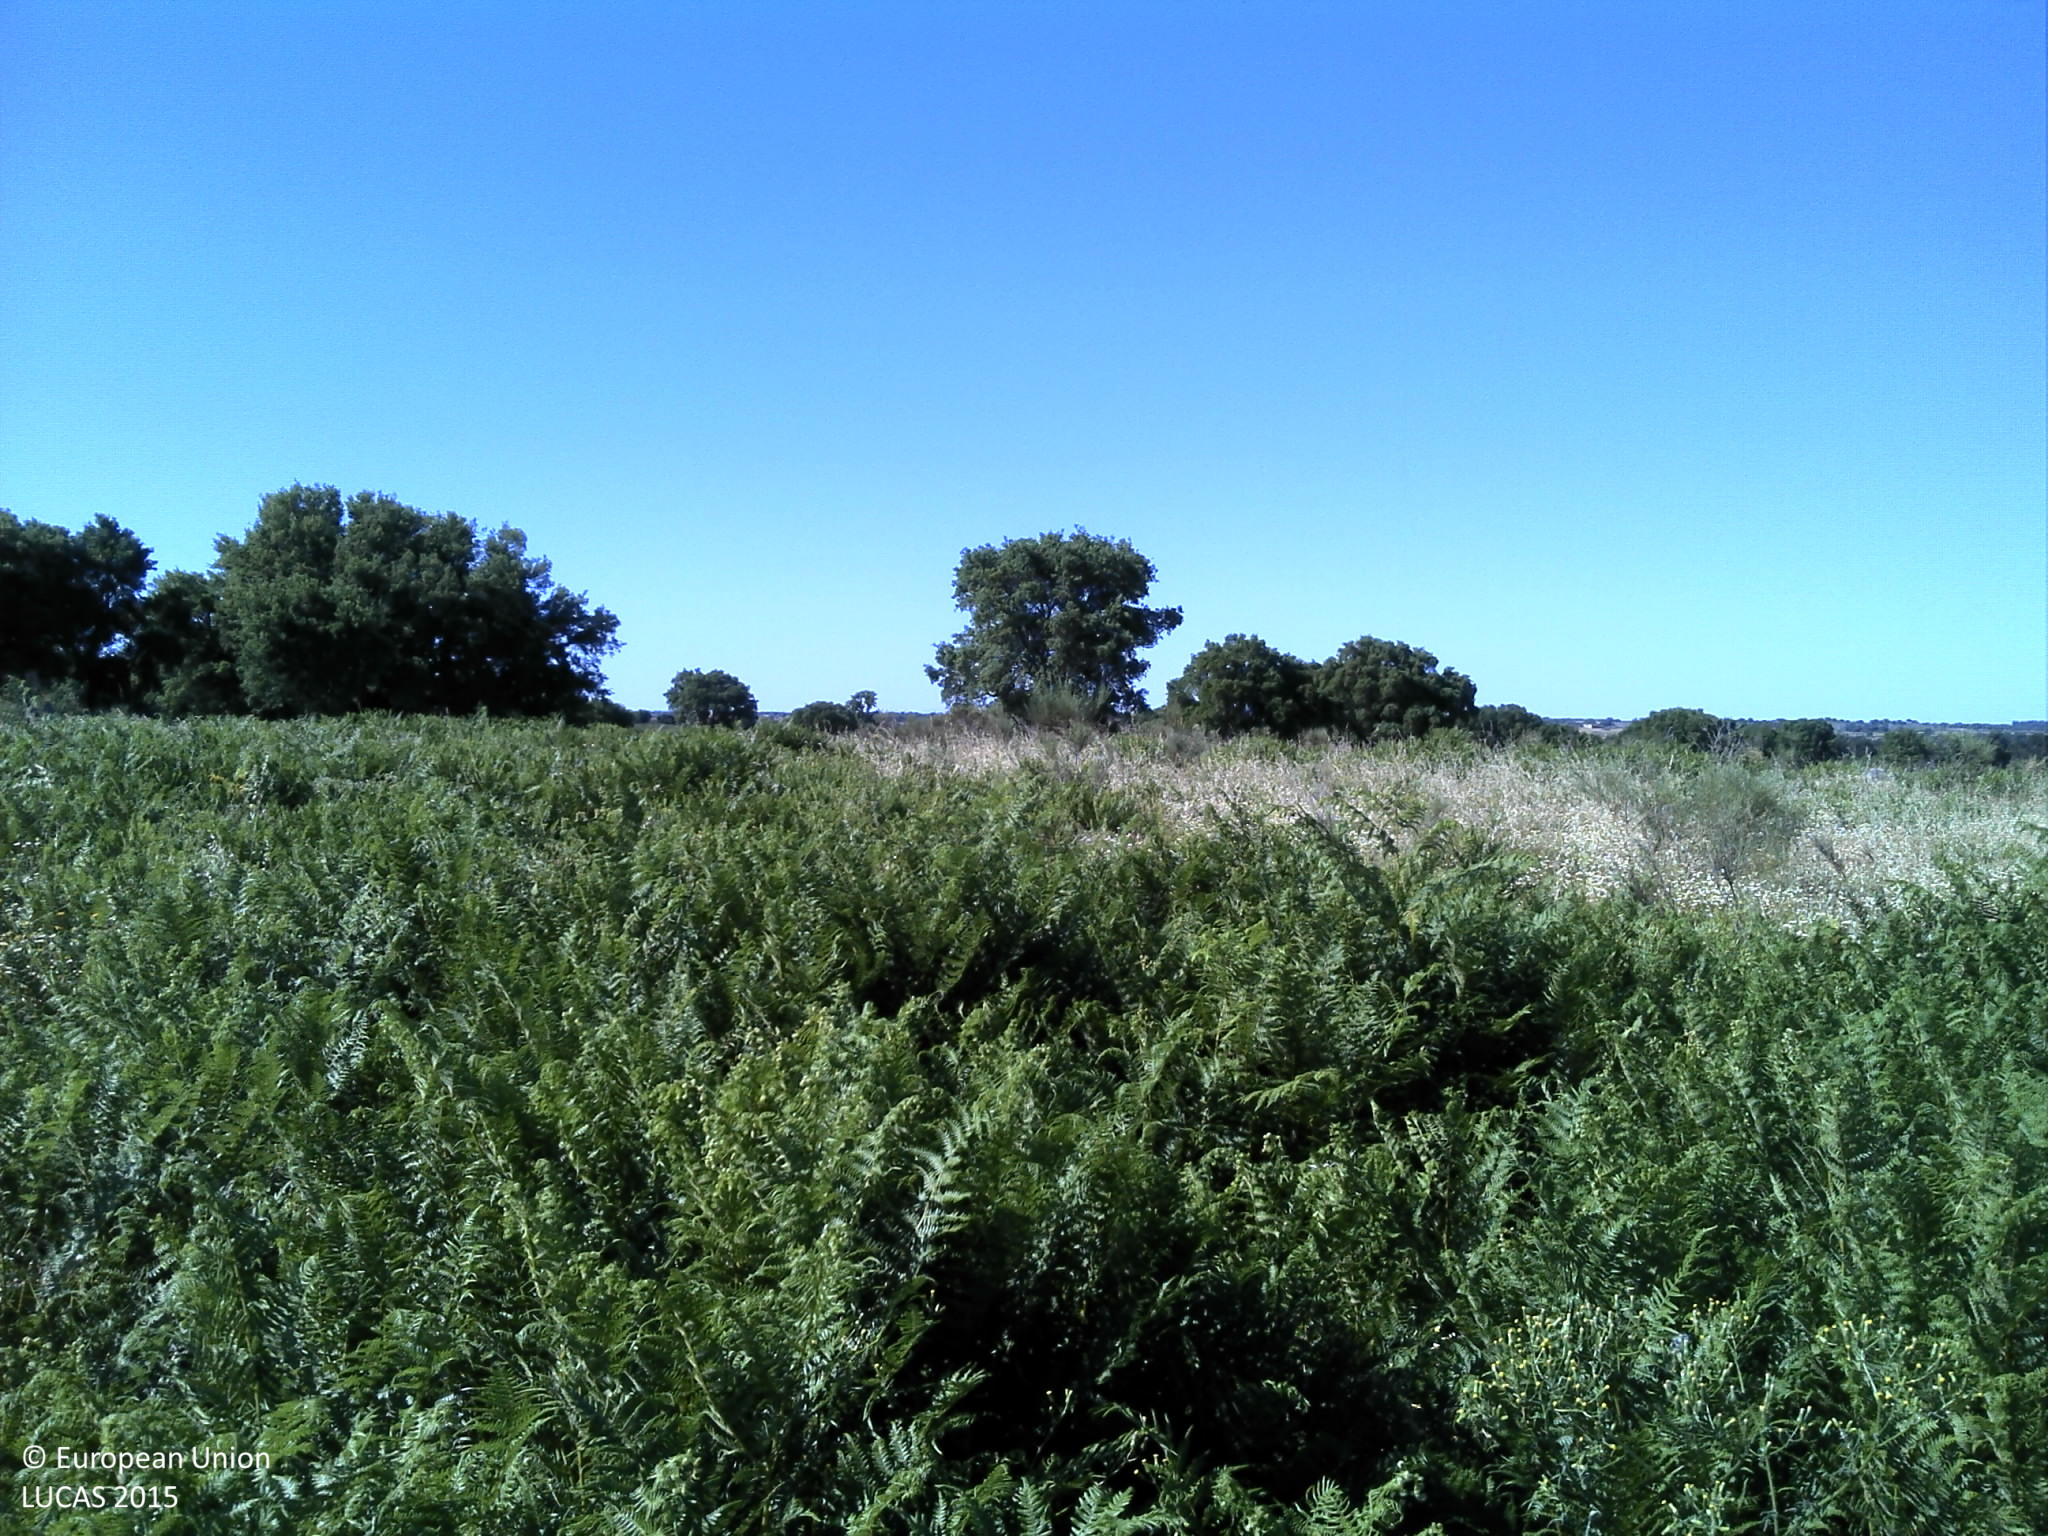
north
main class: Shrubland
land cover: Shrubland without tree cover
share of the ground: > 75 %
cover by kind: shrubs 90 %, herbaceous plants 5 %, unconsolidated bare surface 5 %
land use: Semi-natural and natural areas not in use
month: May
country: PT
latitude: 39.4245
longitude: -7.6717
